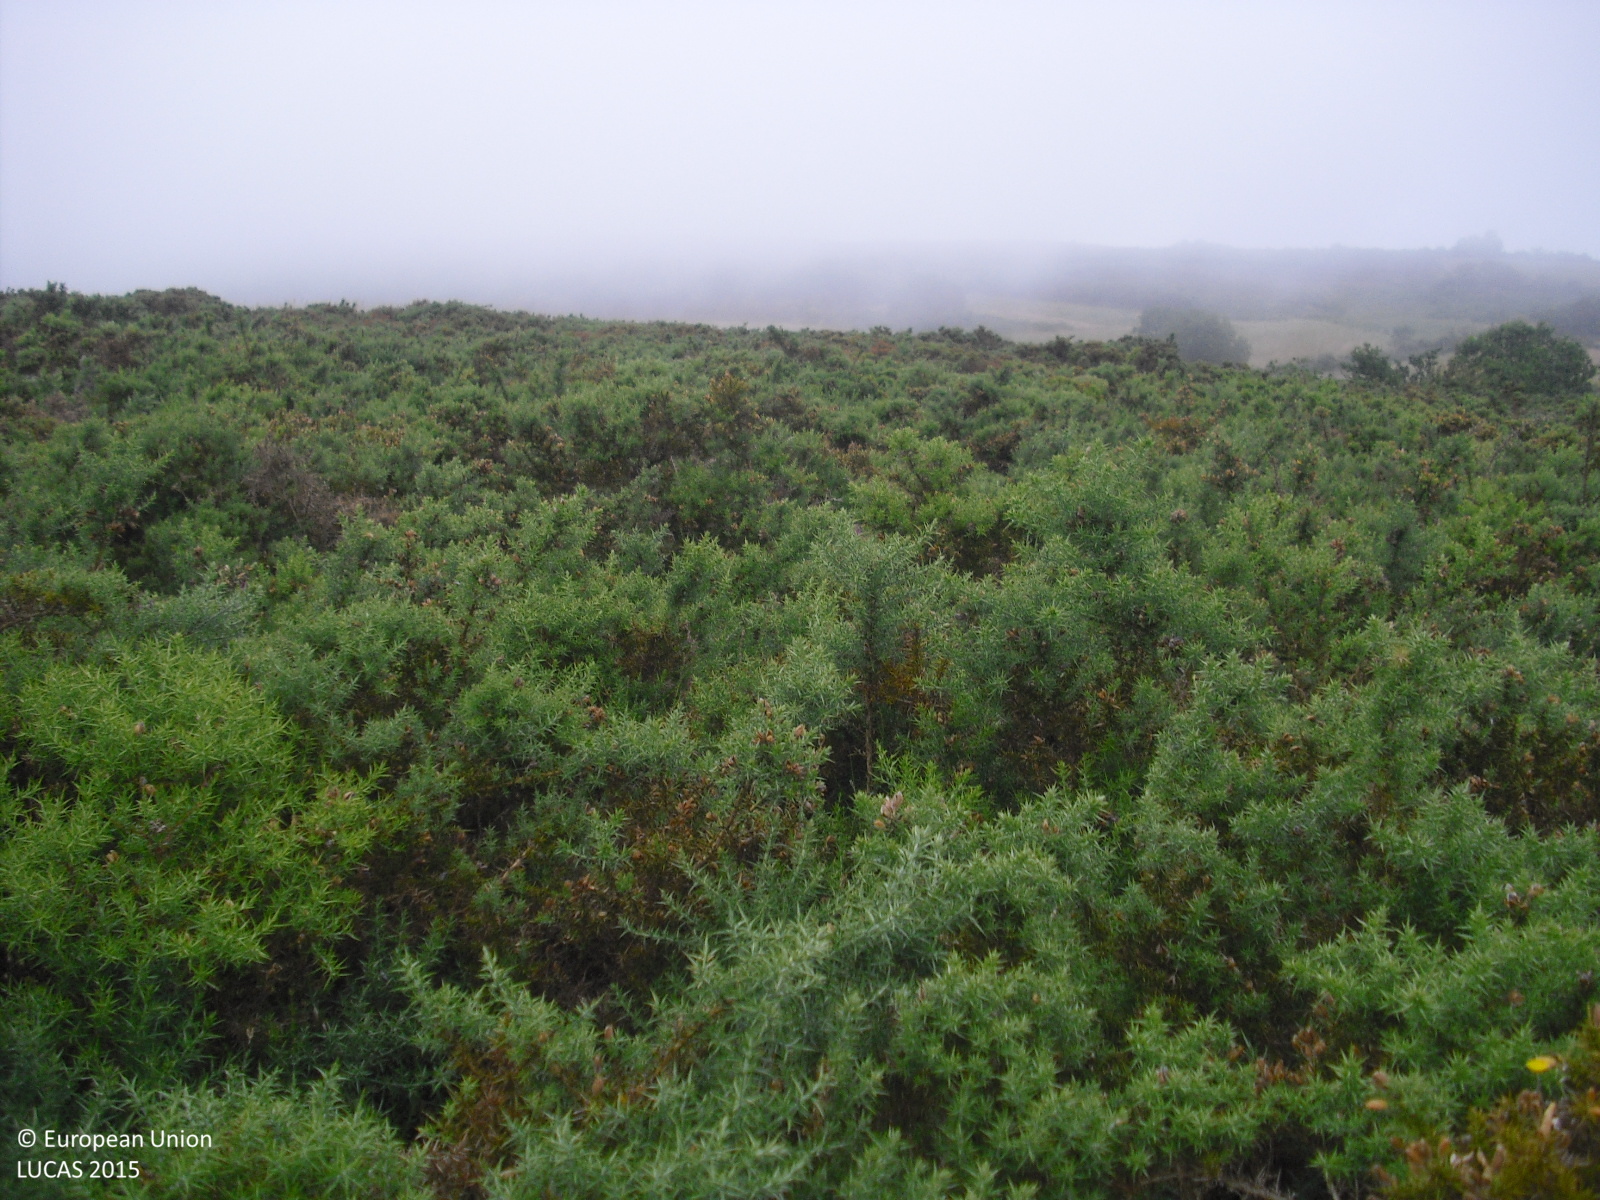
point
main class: Shrubland
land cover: Shrubland without tree cover
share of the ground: > 75 %
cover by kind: shrubs 100 %
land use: Semi-natural and natural areas not in use
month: June
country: ES
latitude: 42.7097
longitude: -7.8714
